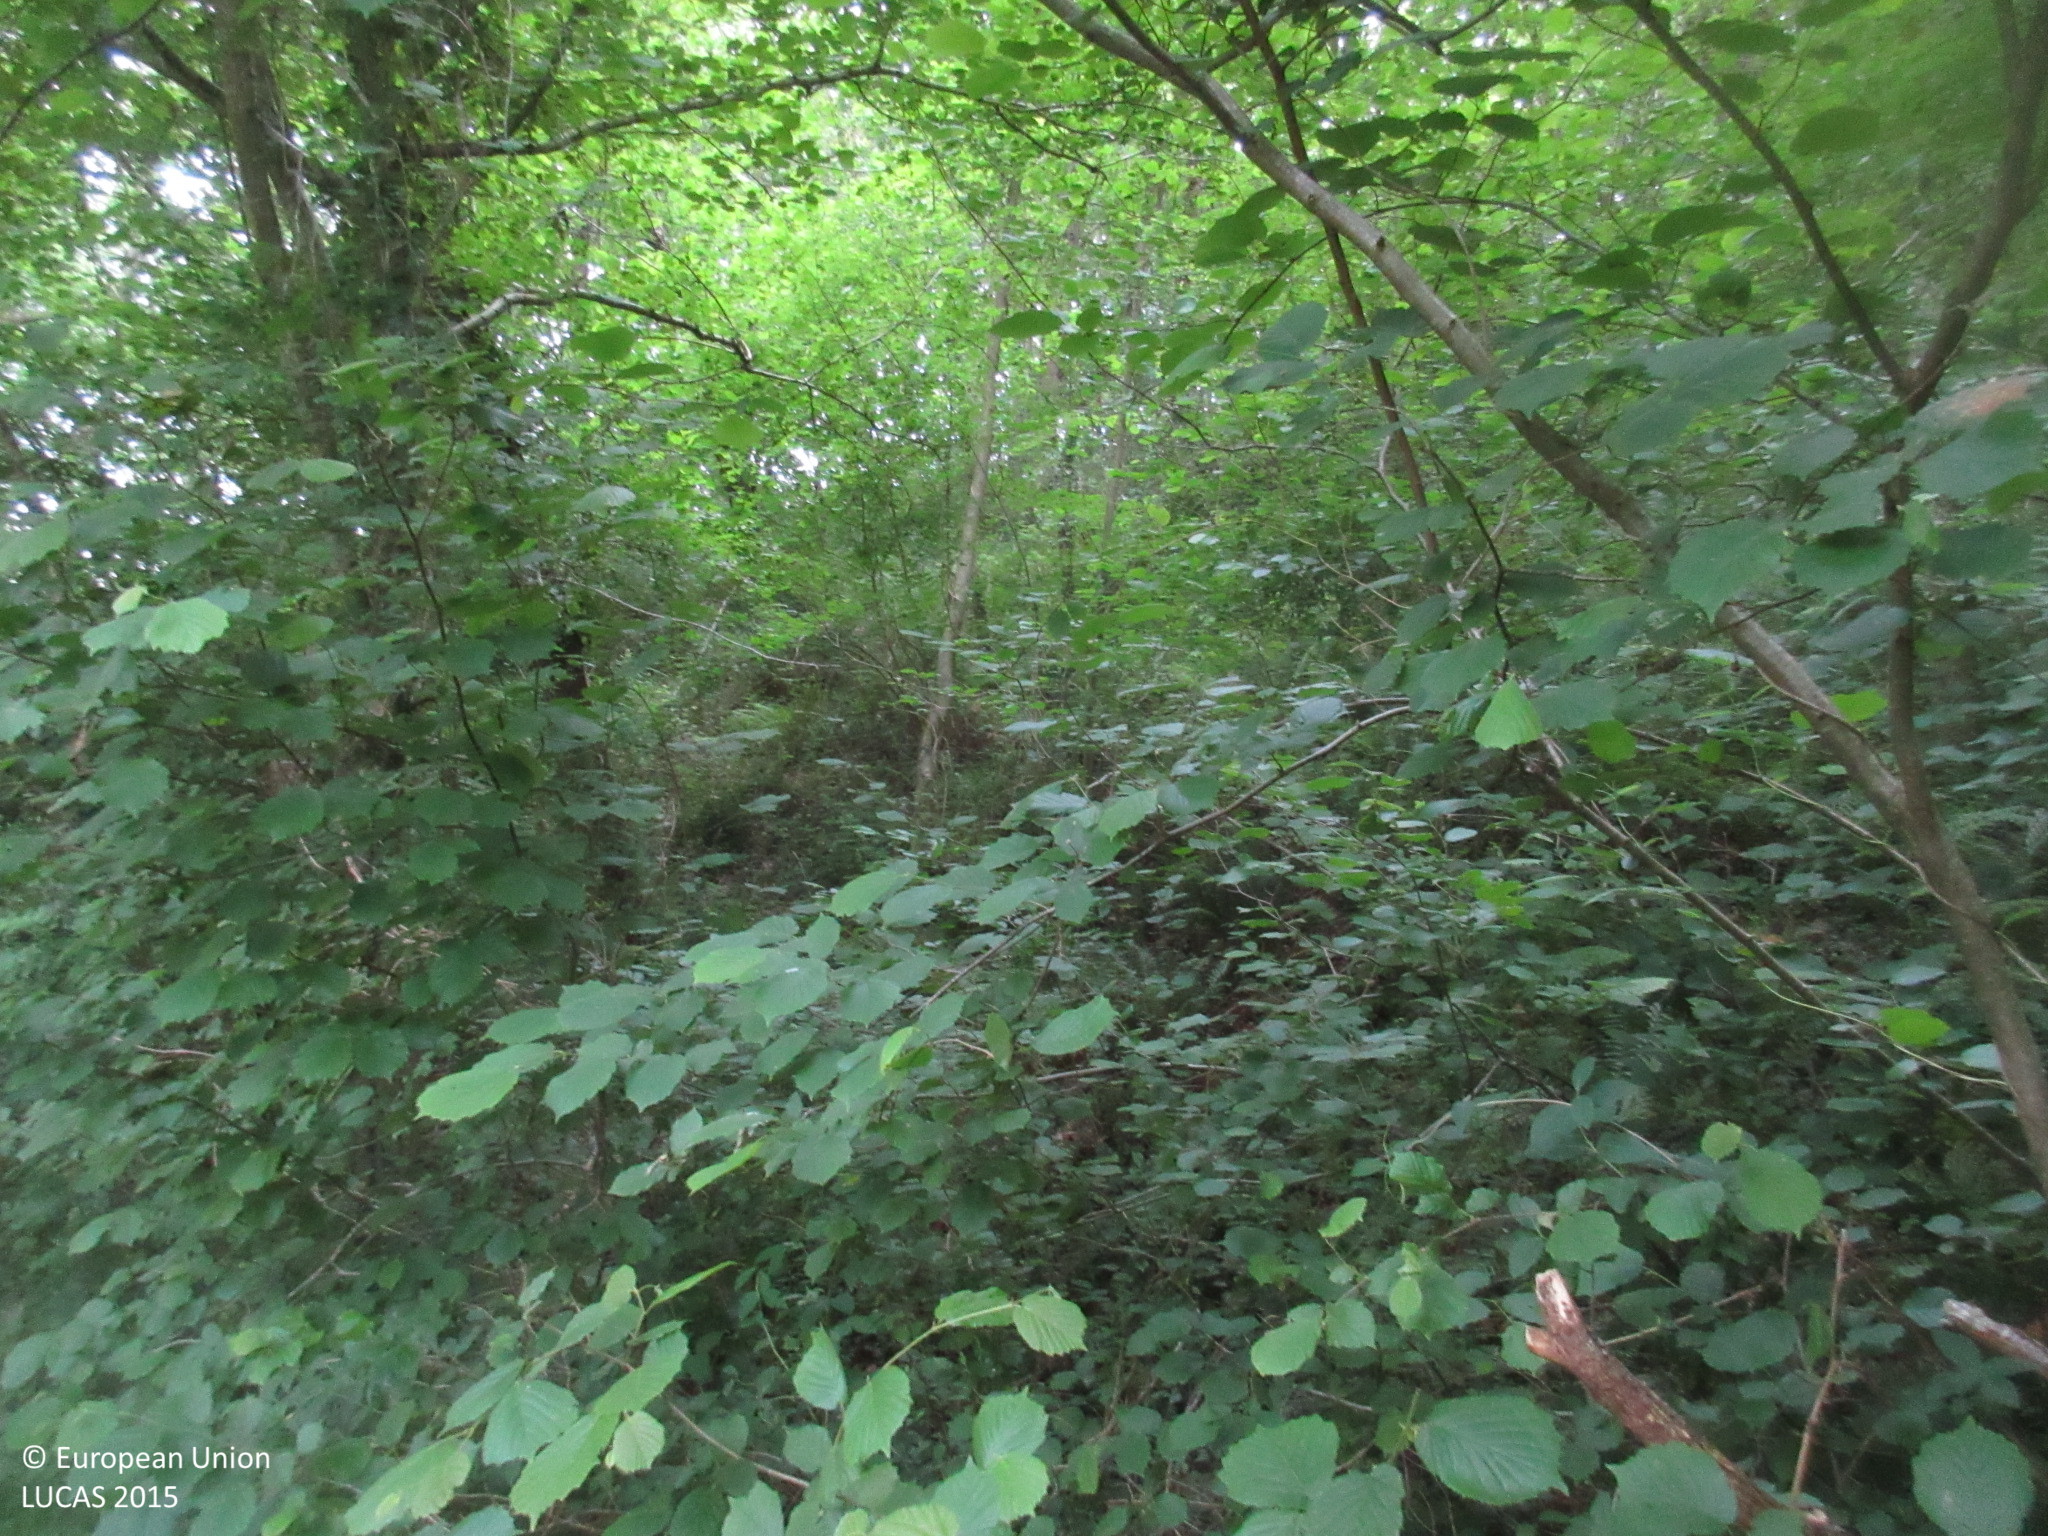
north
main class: Woodland
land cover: Broadleaved woodland
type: thermophilous deciduous forest
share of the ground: > 75 %
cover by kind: broadleaved forest trees 100 %
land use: Forestry
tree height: > 5 m
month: June
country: ES
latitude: 43.2892
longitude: -3.4386
